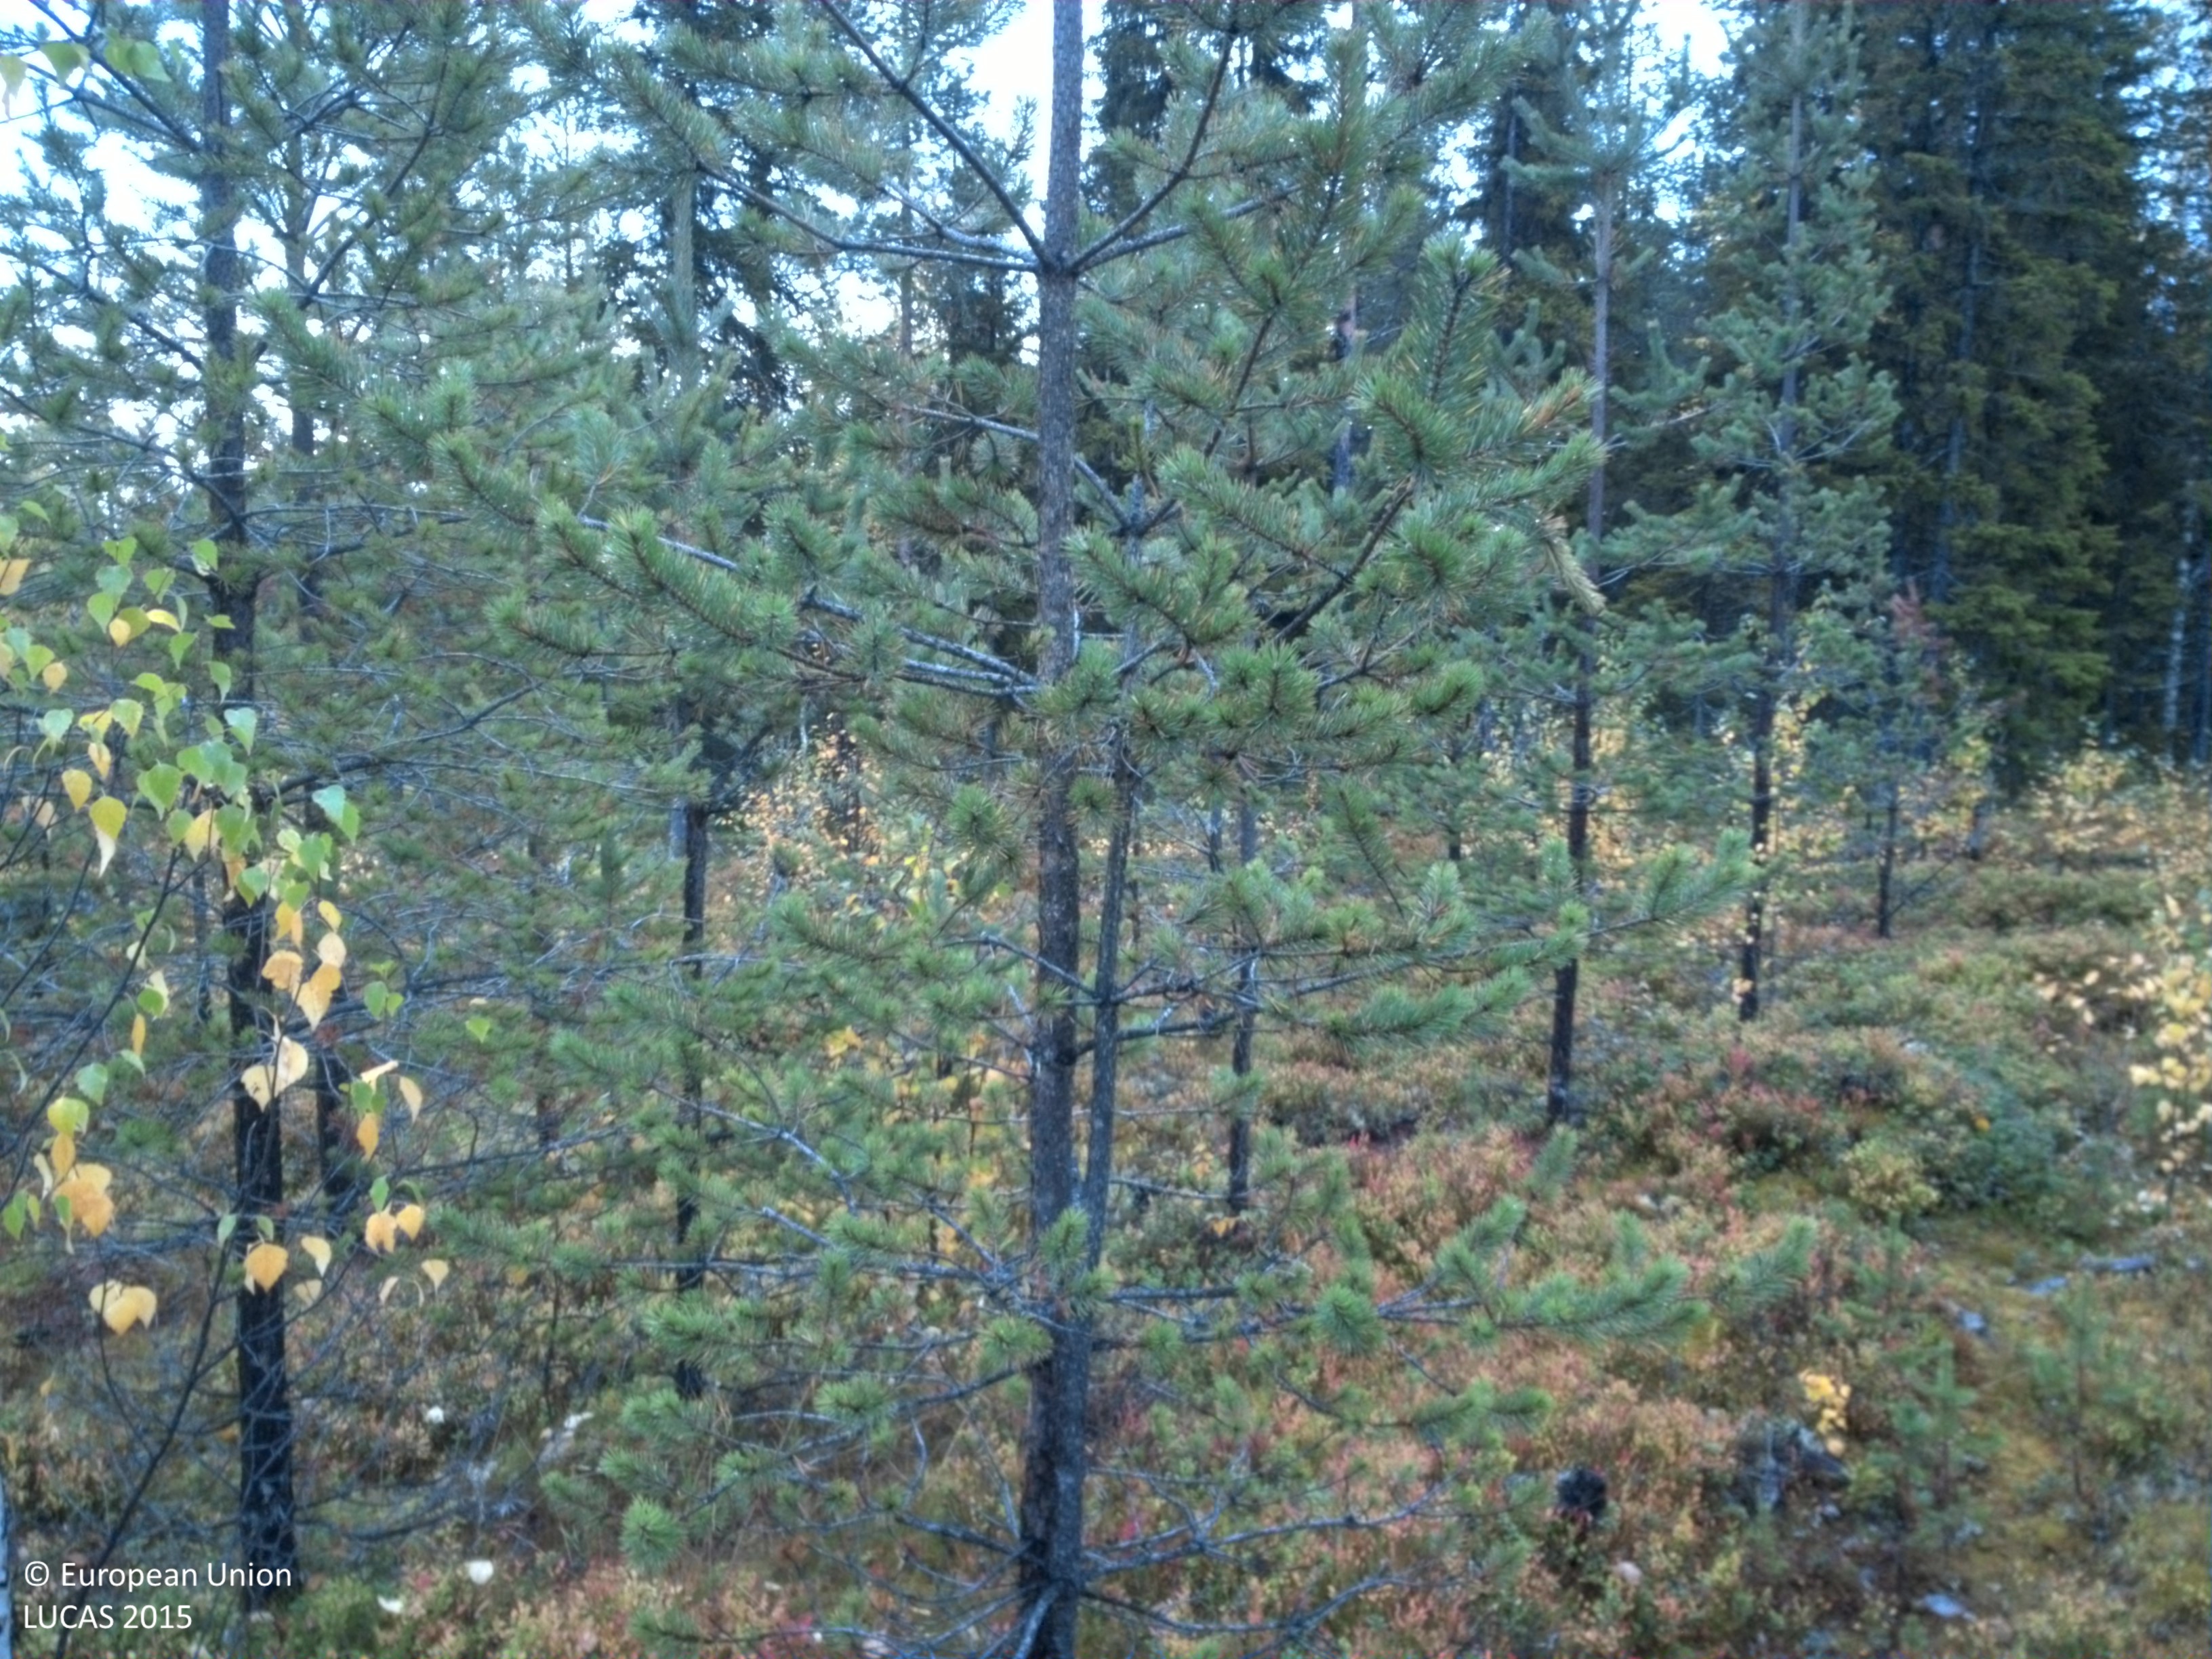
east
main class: Woodland
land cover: Pine dominated mixed woodland
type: boreal forest
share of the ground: 25 - 50 %
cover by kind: coniferous forest trees 30 %, shrubs 30 %, herbaceous plants 15 %, lichens and mosses 15 %, broadleaved forest trees 10 %
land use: Forestry
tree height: > 5 m
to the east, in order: Pine dominated mixed woodland; Other coniferous woodland; Pine dominated mixed woodland
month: September
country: SE
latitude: 65.0735
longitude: 17.5121
